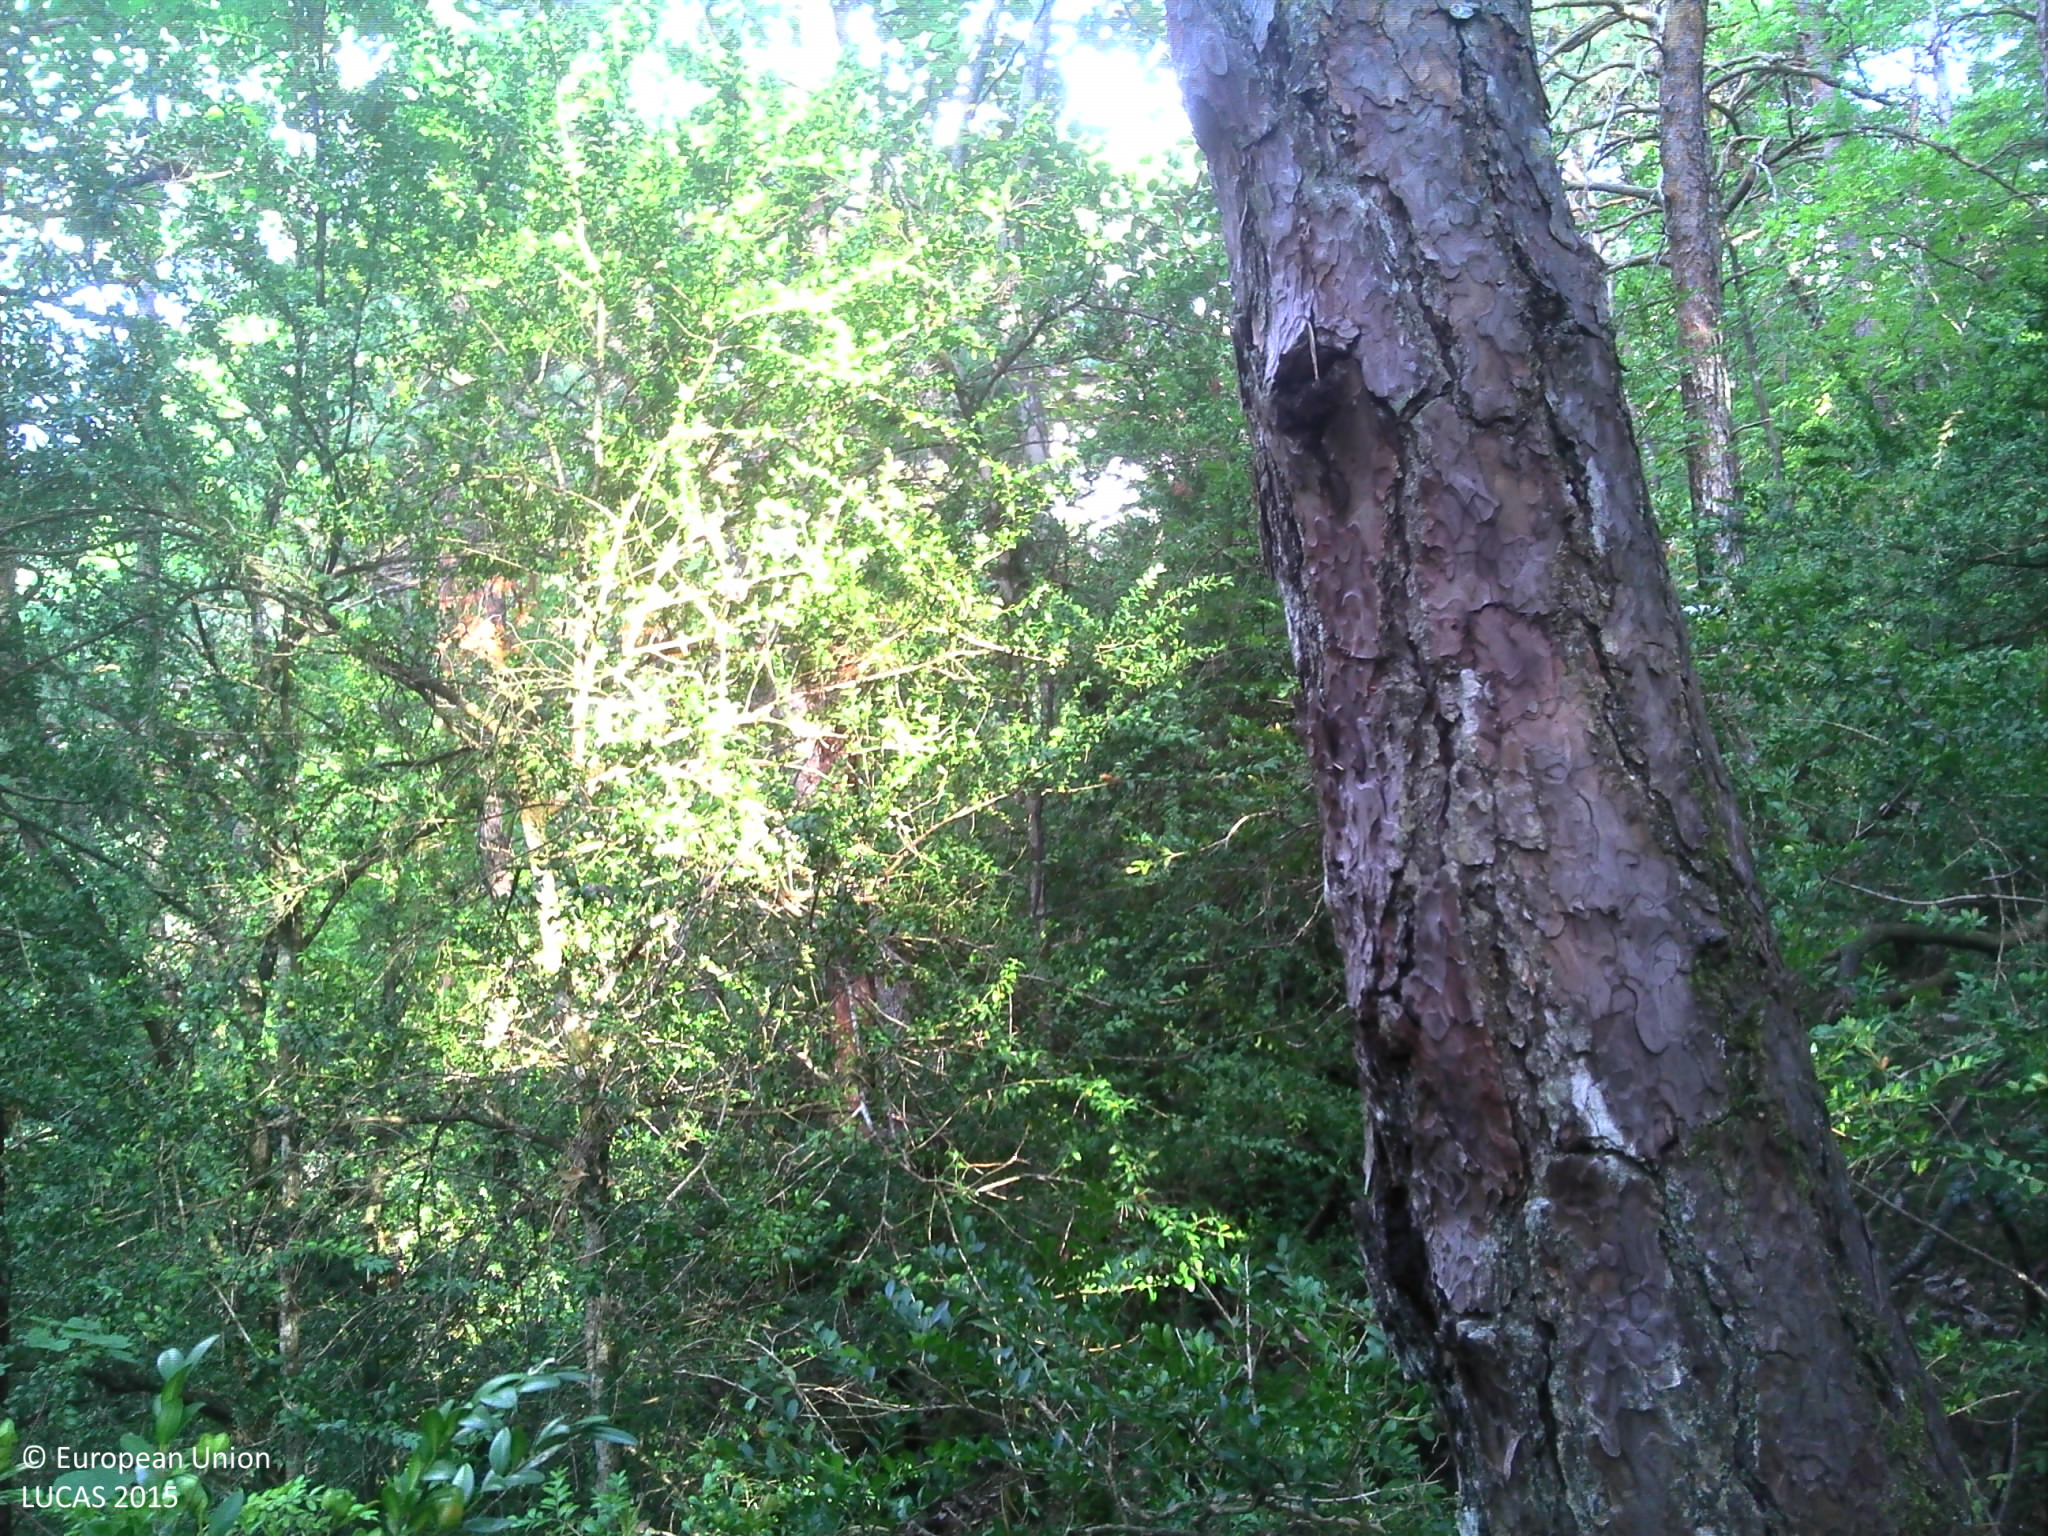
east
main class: Woodland
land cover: Pine dominated mixed woodland
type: coniferous forest of the mediterranean region
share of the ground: > 75 %
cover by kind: broadleaved forest trees 65 %, coniferous forest trees 25 %, herbaceous plants 10 %
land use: Forestry
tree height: > 5 m
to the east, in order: Pine dominated mixed woodland
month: September
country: FR
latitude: 44.6865
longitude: 5.5022
